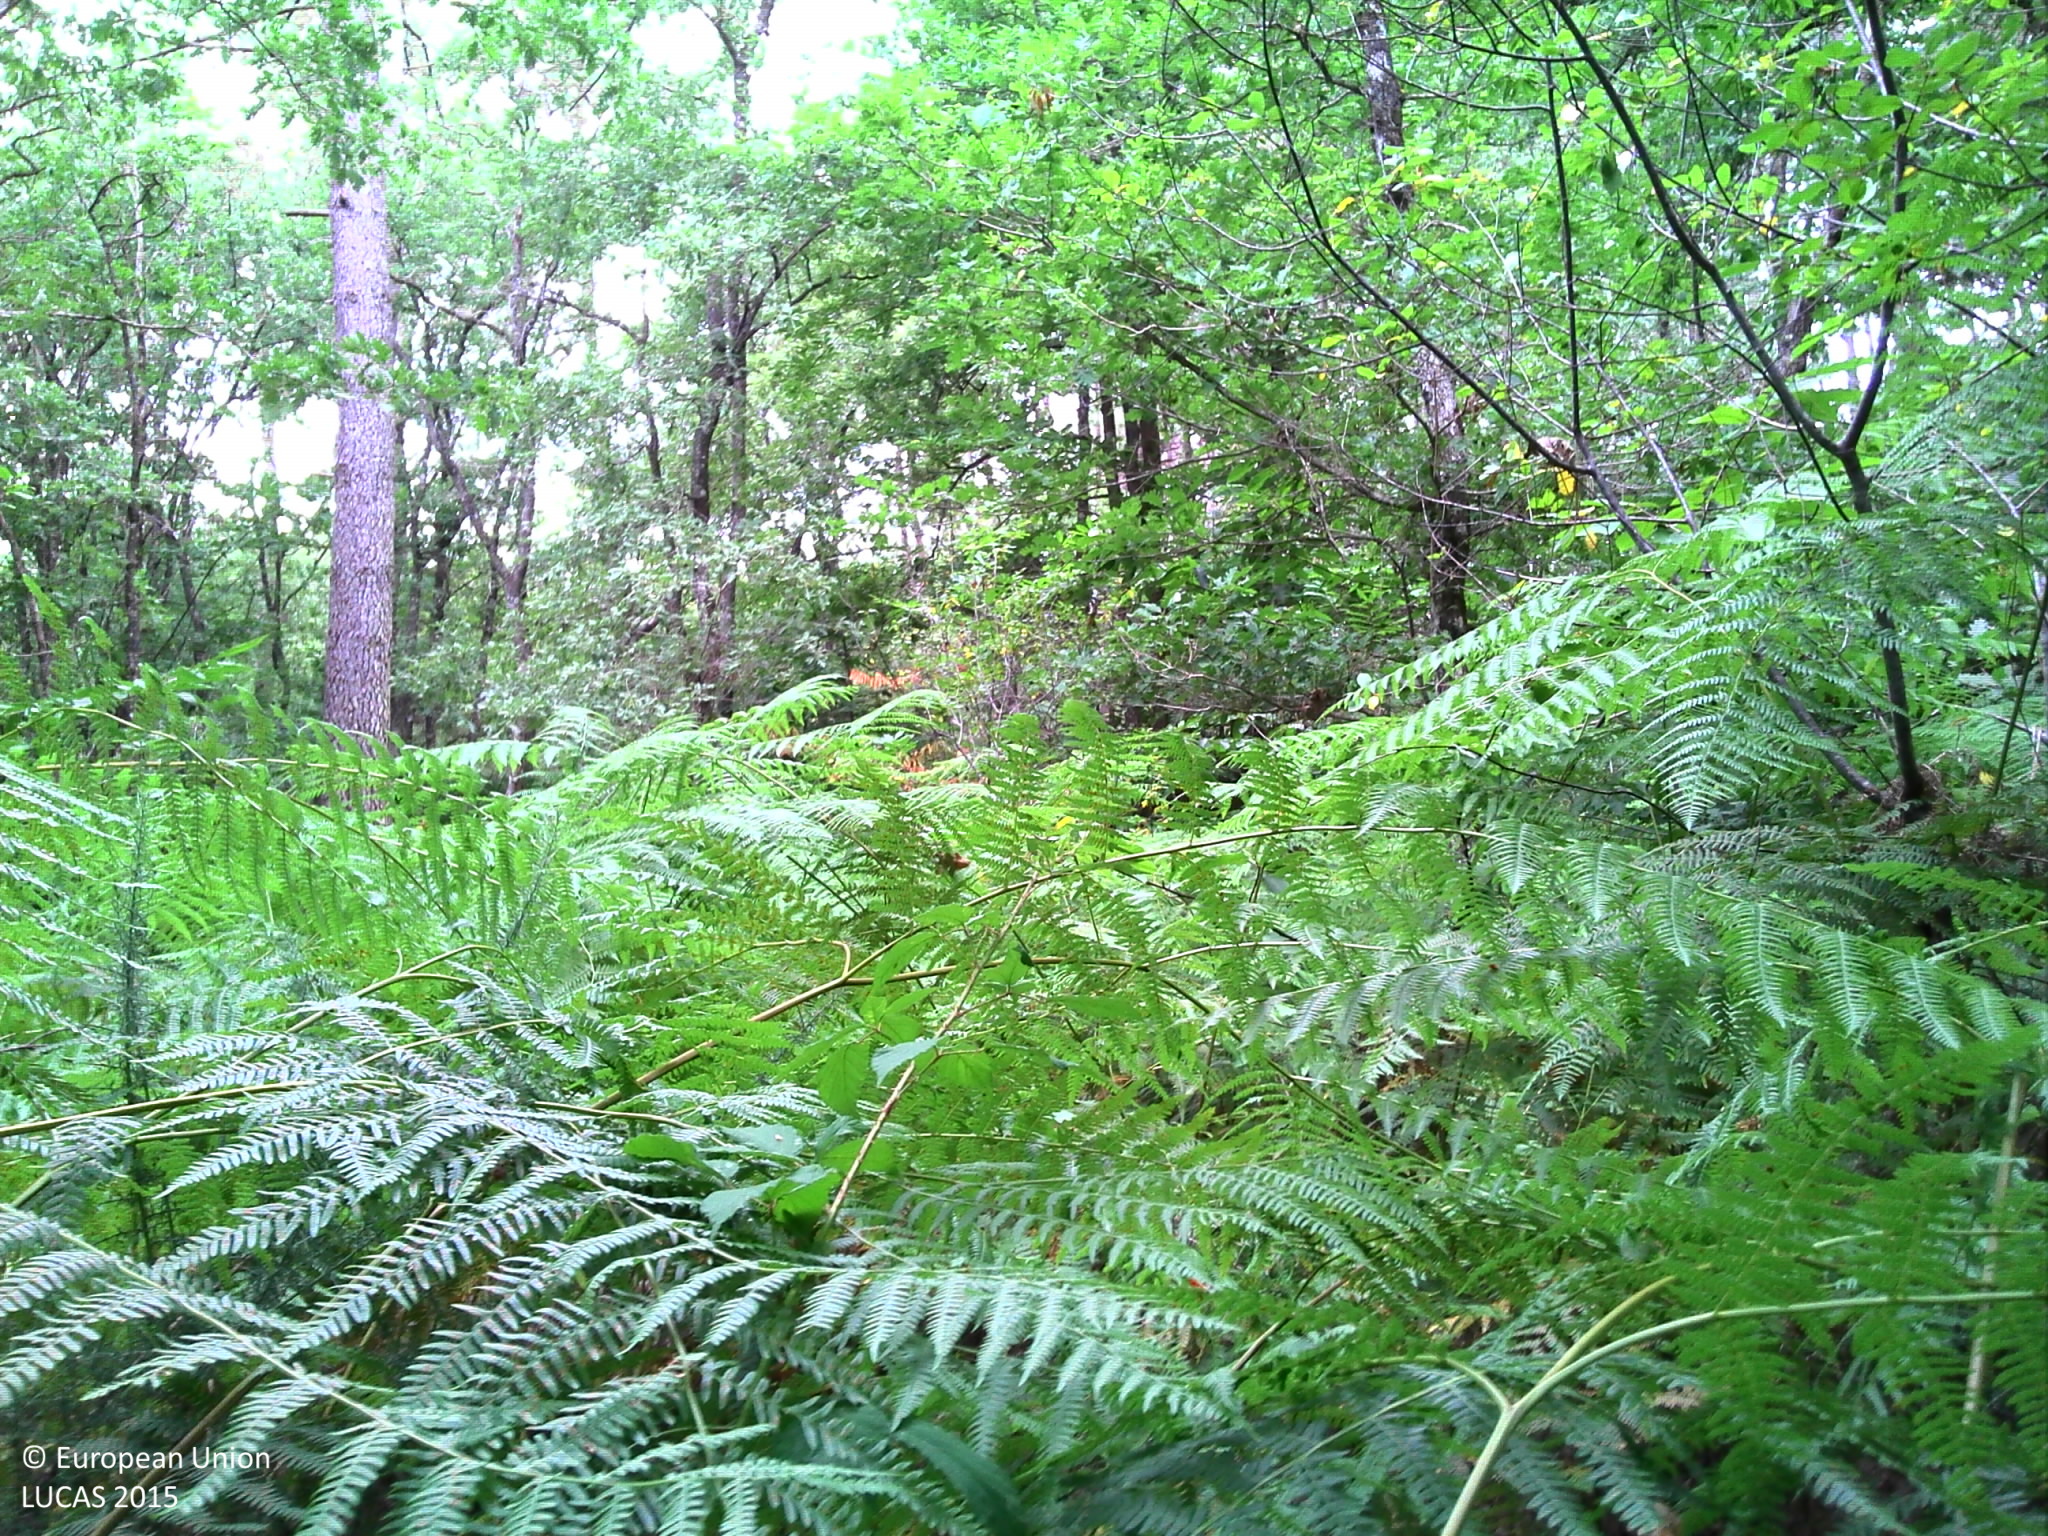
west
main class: Woodland
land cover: Broadleaved woodland
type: acidophilous oak and oak-birch forest
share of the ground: 50 - 75 %
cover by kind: broadleaved forest trees 75 %, herbaceous plants 15 %, shrubs 5 %, lichens and mosses 5 %
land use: Forestry
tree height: > 5 m
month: July
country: FR
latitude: 45.0821
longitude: 0.7807
